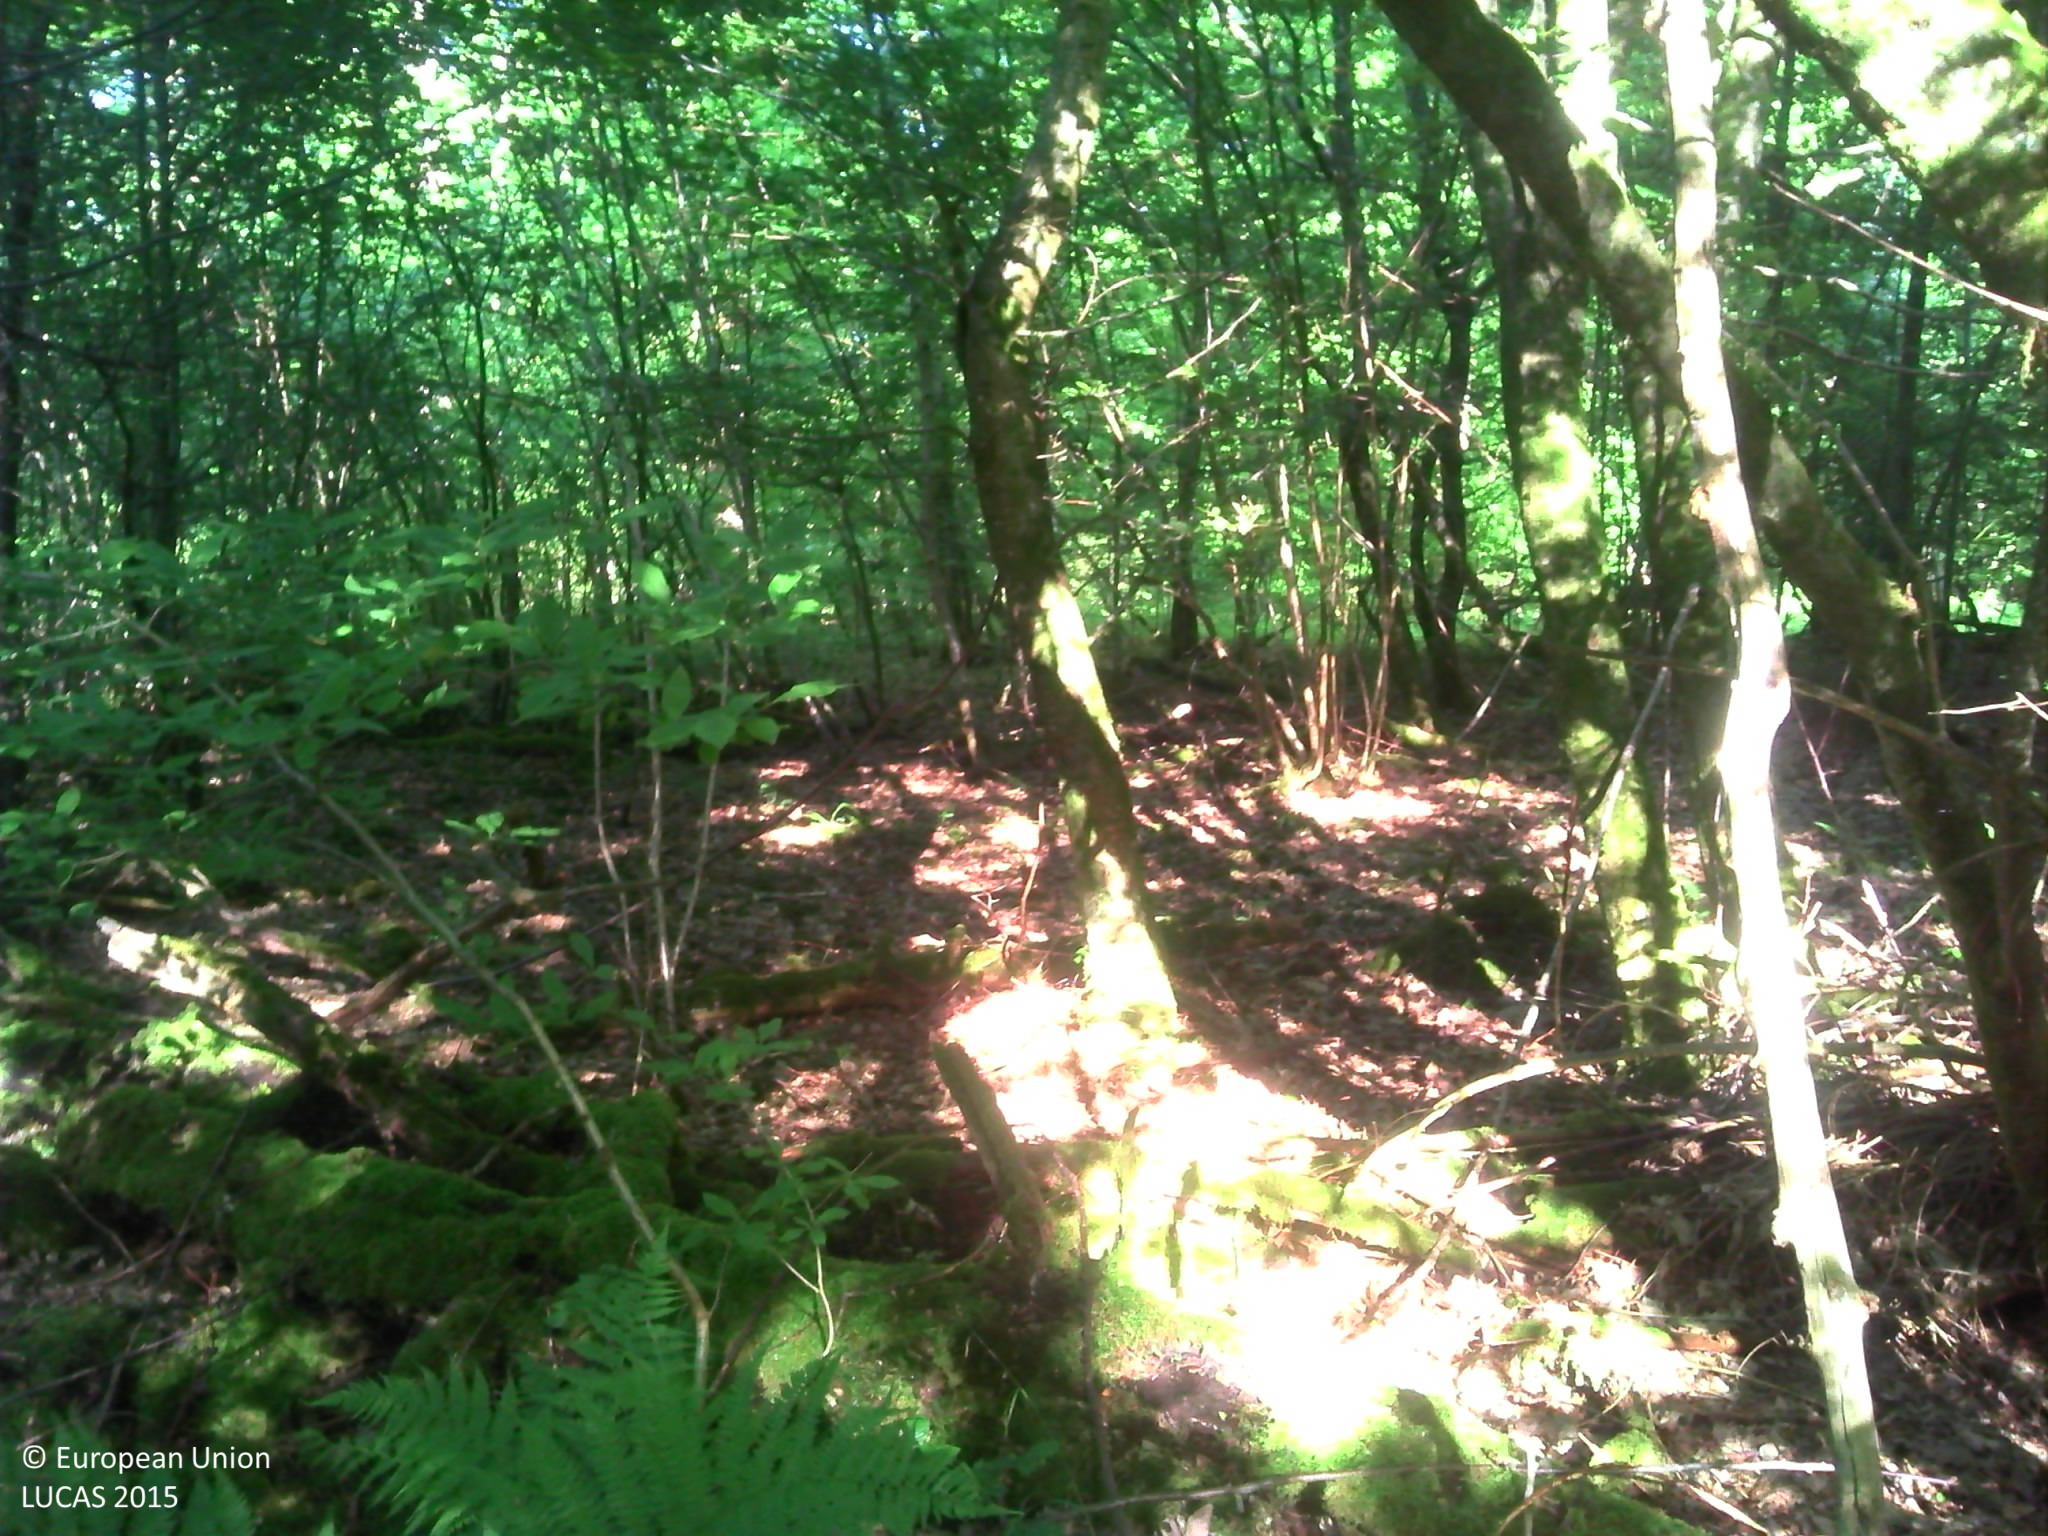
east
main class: Woodland
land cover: Broadleaved woodland
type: mesophytic deciduous forest
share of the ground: > 75 %
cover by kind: broadleaved forest trees 90 %, shrubs 10 %
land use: Forestry
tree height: > 5 m
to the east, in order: Broadleaved woodland; Tracks; Broadleaved woodland
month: June
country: FR
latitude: 48.5354
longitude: 4.8381
